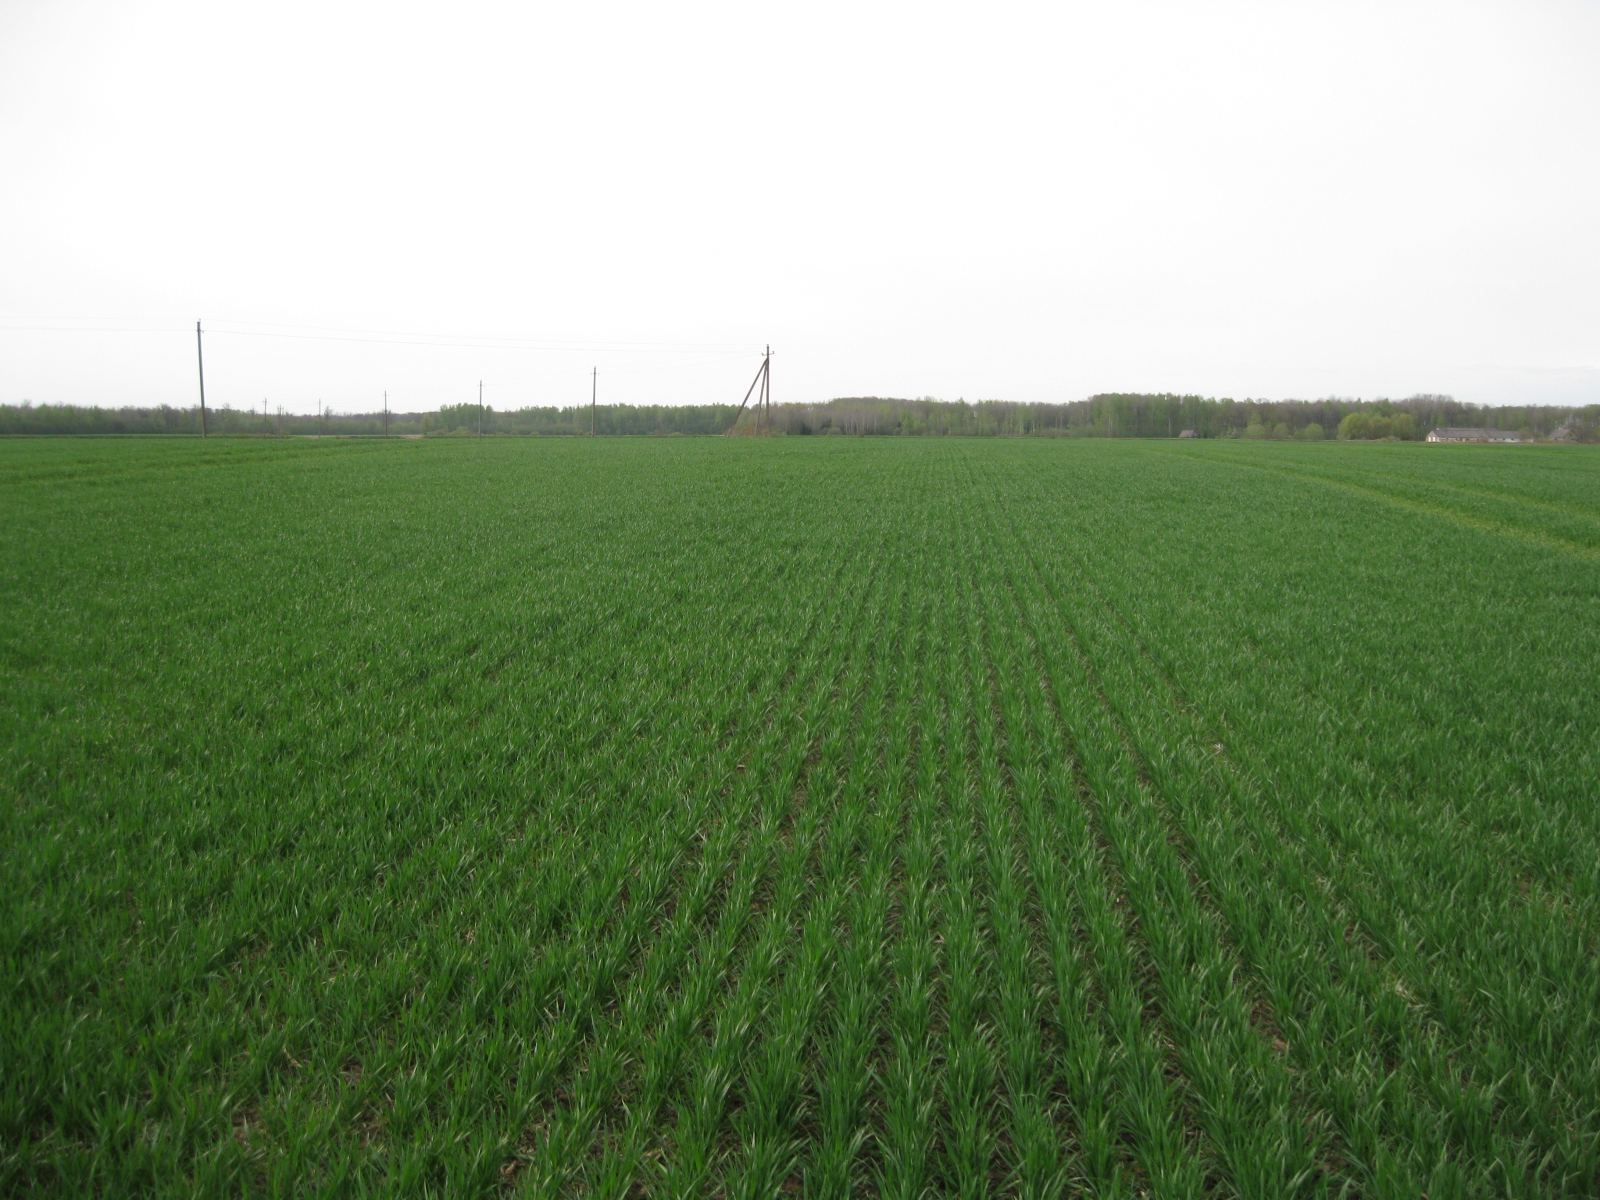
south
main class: Cropland
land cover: Common wheat
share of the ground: > 75 %
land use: Agriculture (excluding fallow land and kitchen gardens)
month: May
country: LT
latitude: 56.2572
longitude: 24.4793
